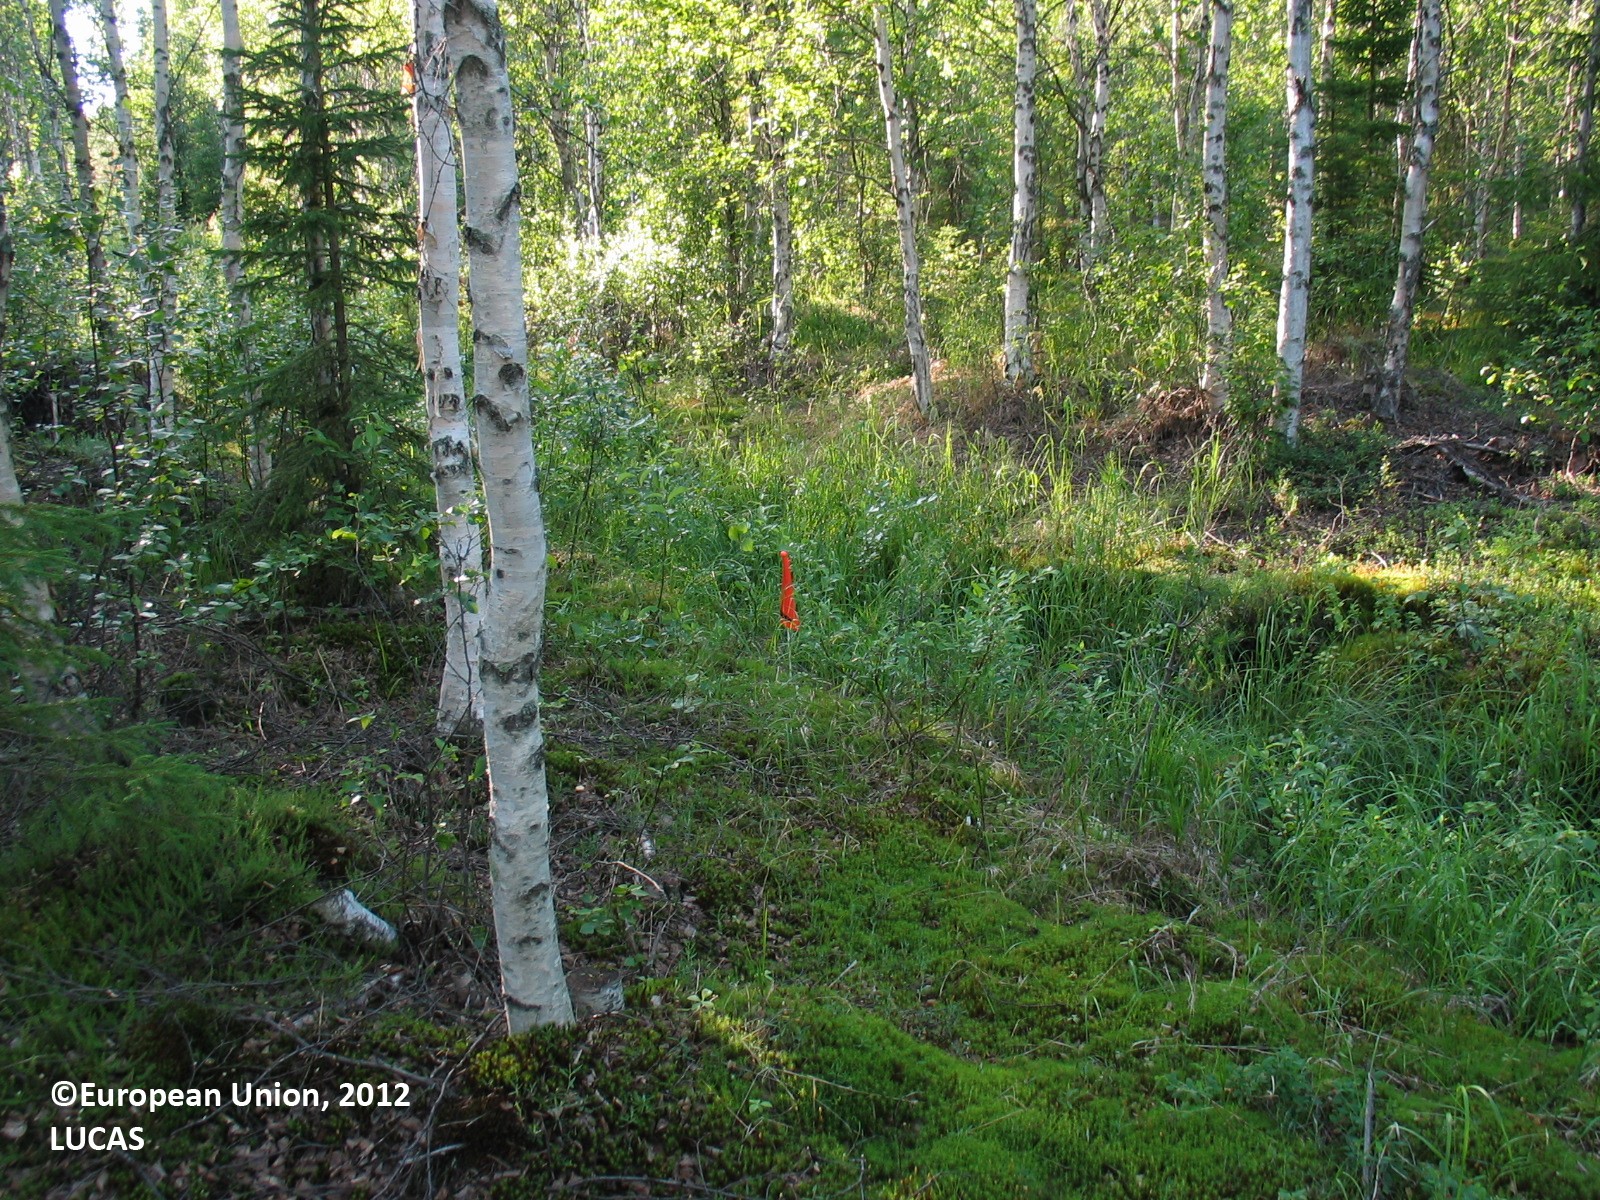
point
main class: Woodland
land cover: Broadleaved woodland
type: boreal forest
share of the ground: 25 - 50 %
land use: Forestry
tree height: > 5 m
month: July
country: FI
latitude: 65.7983
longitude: 24.8602
